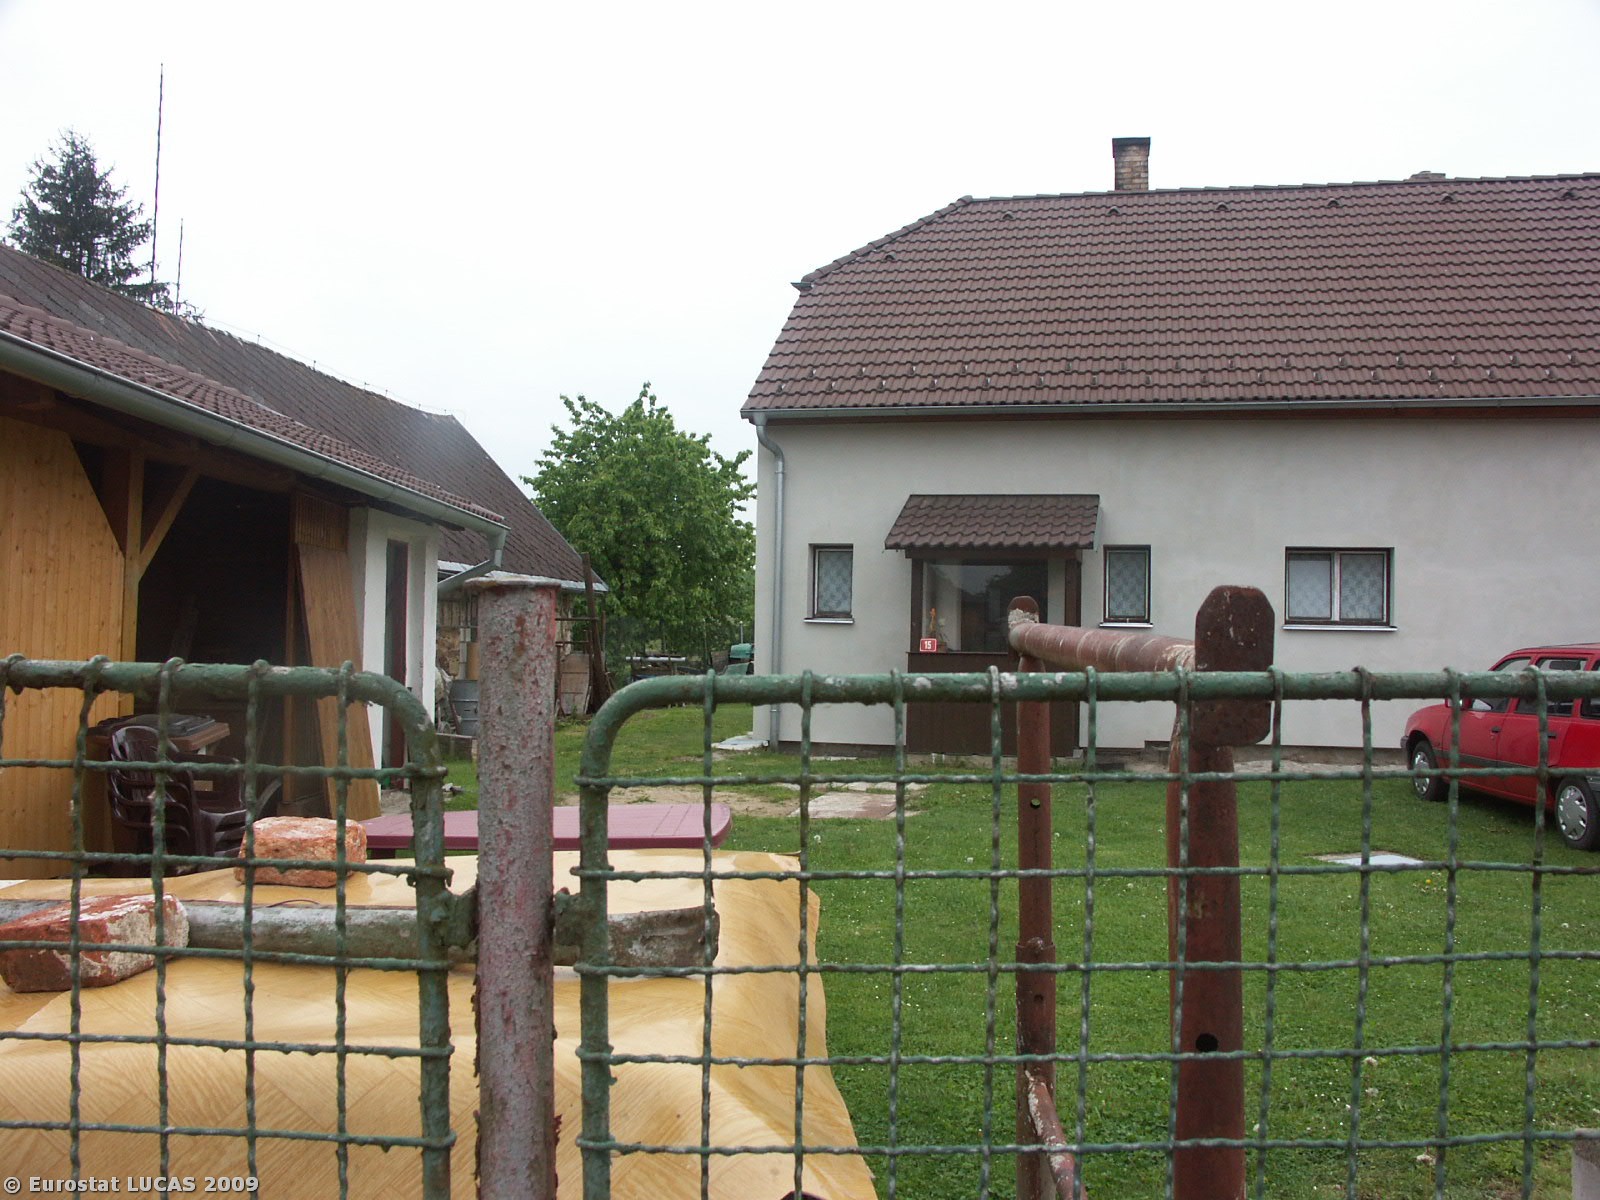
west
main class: Cropland
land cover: Cherry fruit
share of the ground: 50 - 75 %
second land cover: Grassland with sparse tree/shrub cover
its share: > 75 %
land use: Kitchen garden
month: May
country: CZ
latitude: 49.1577
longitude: 14.9523
